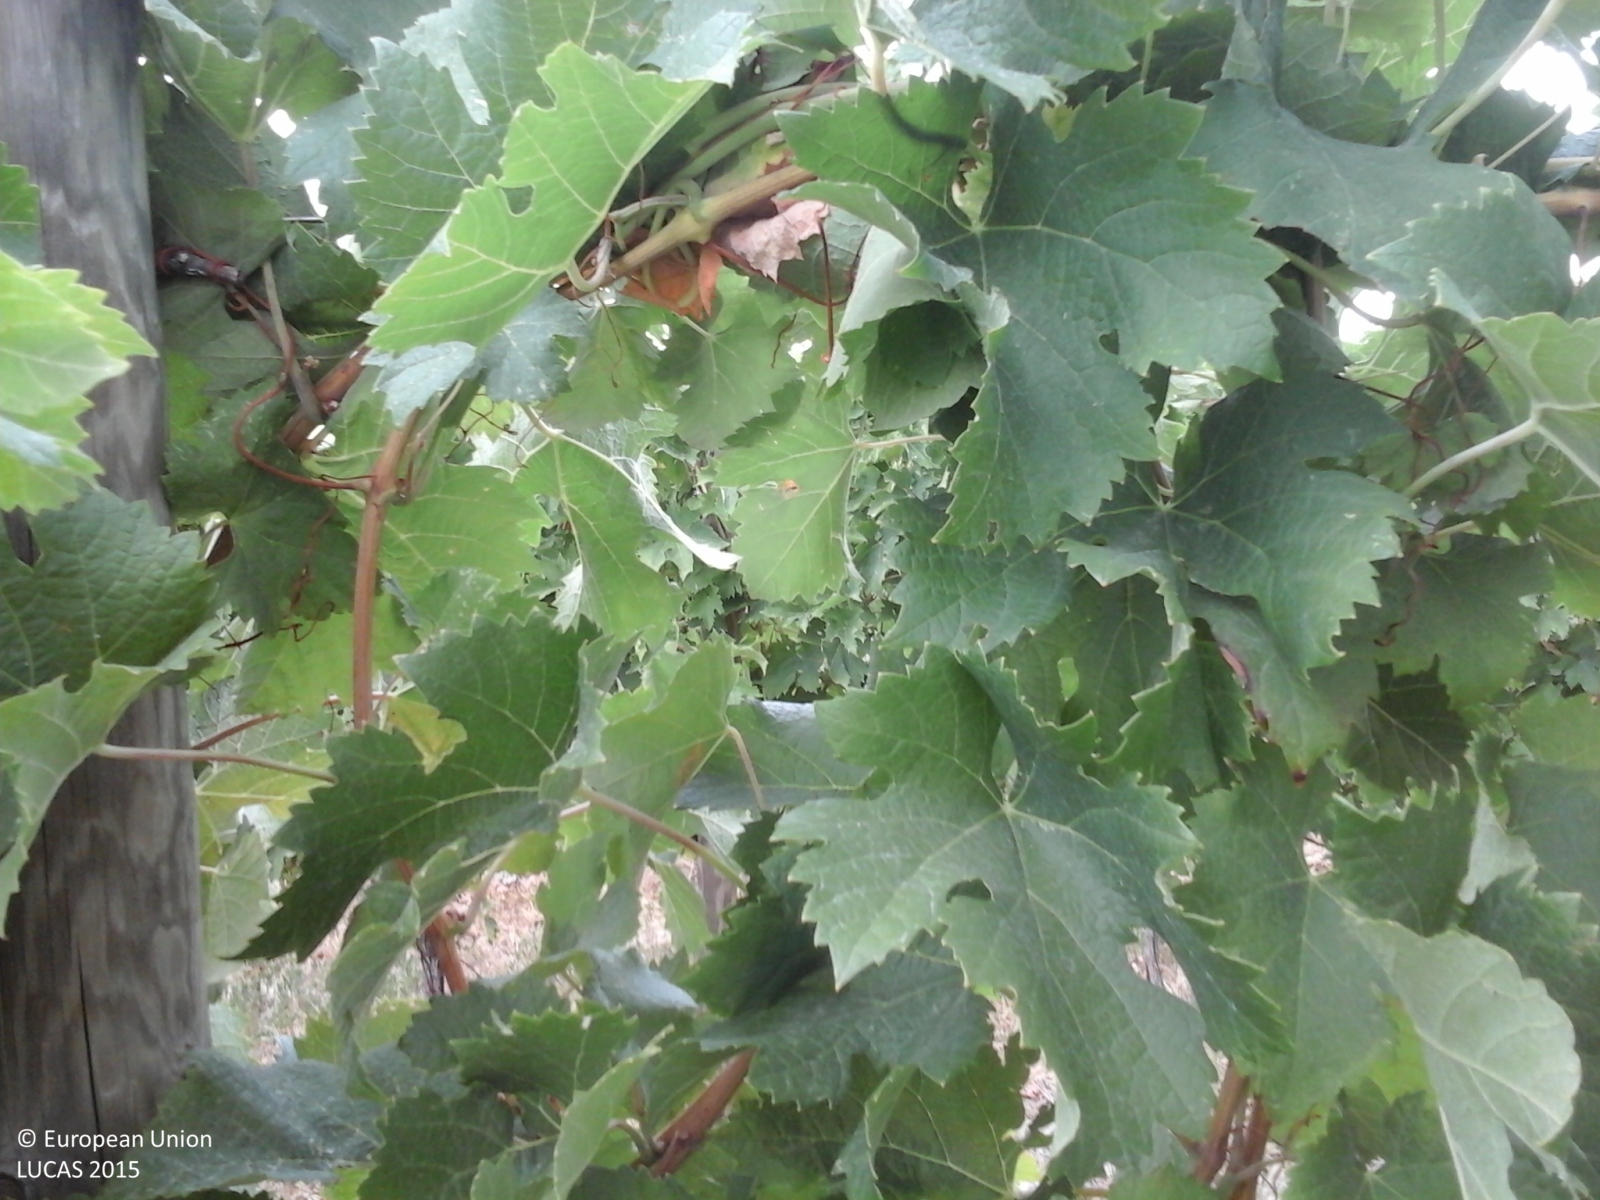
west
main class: Cropland
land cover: Vineyards
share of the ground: 50 - 75 %
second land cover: Spontaneously vegetated surfaces
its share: 50 - 75 %
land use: Agriculture (excluding fallow land and kitchen gardens)
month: July
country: IT
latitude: 43.2718
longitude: 13.2074
